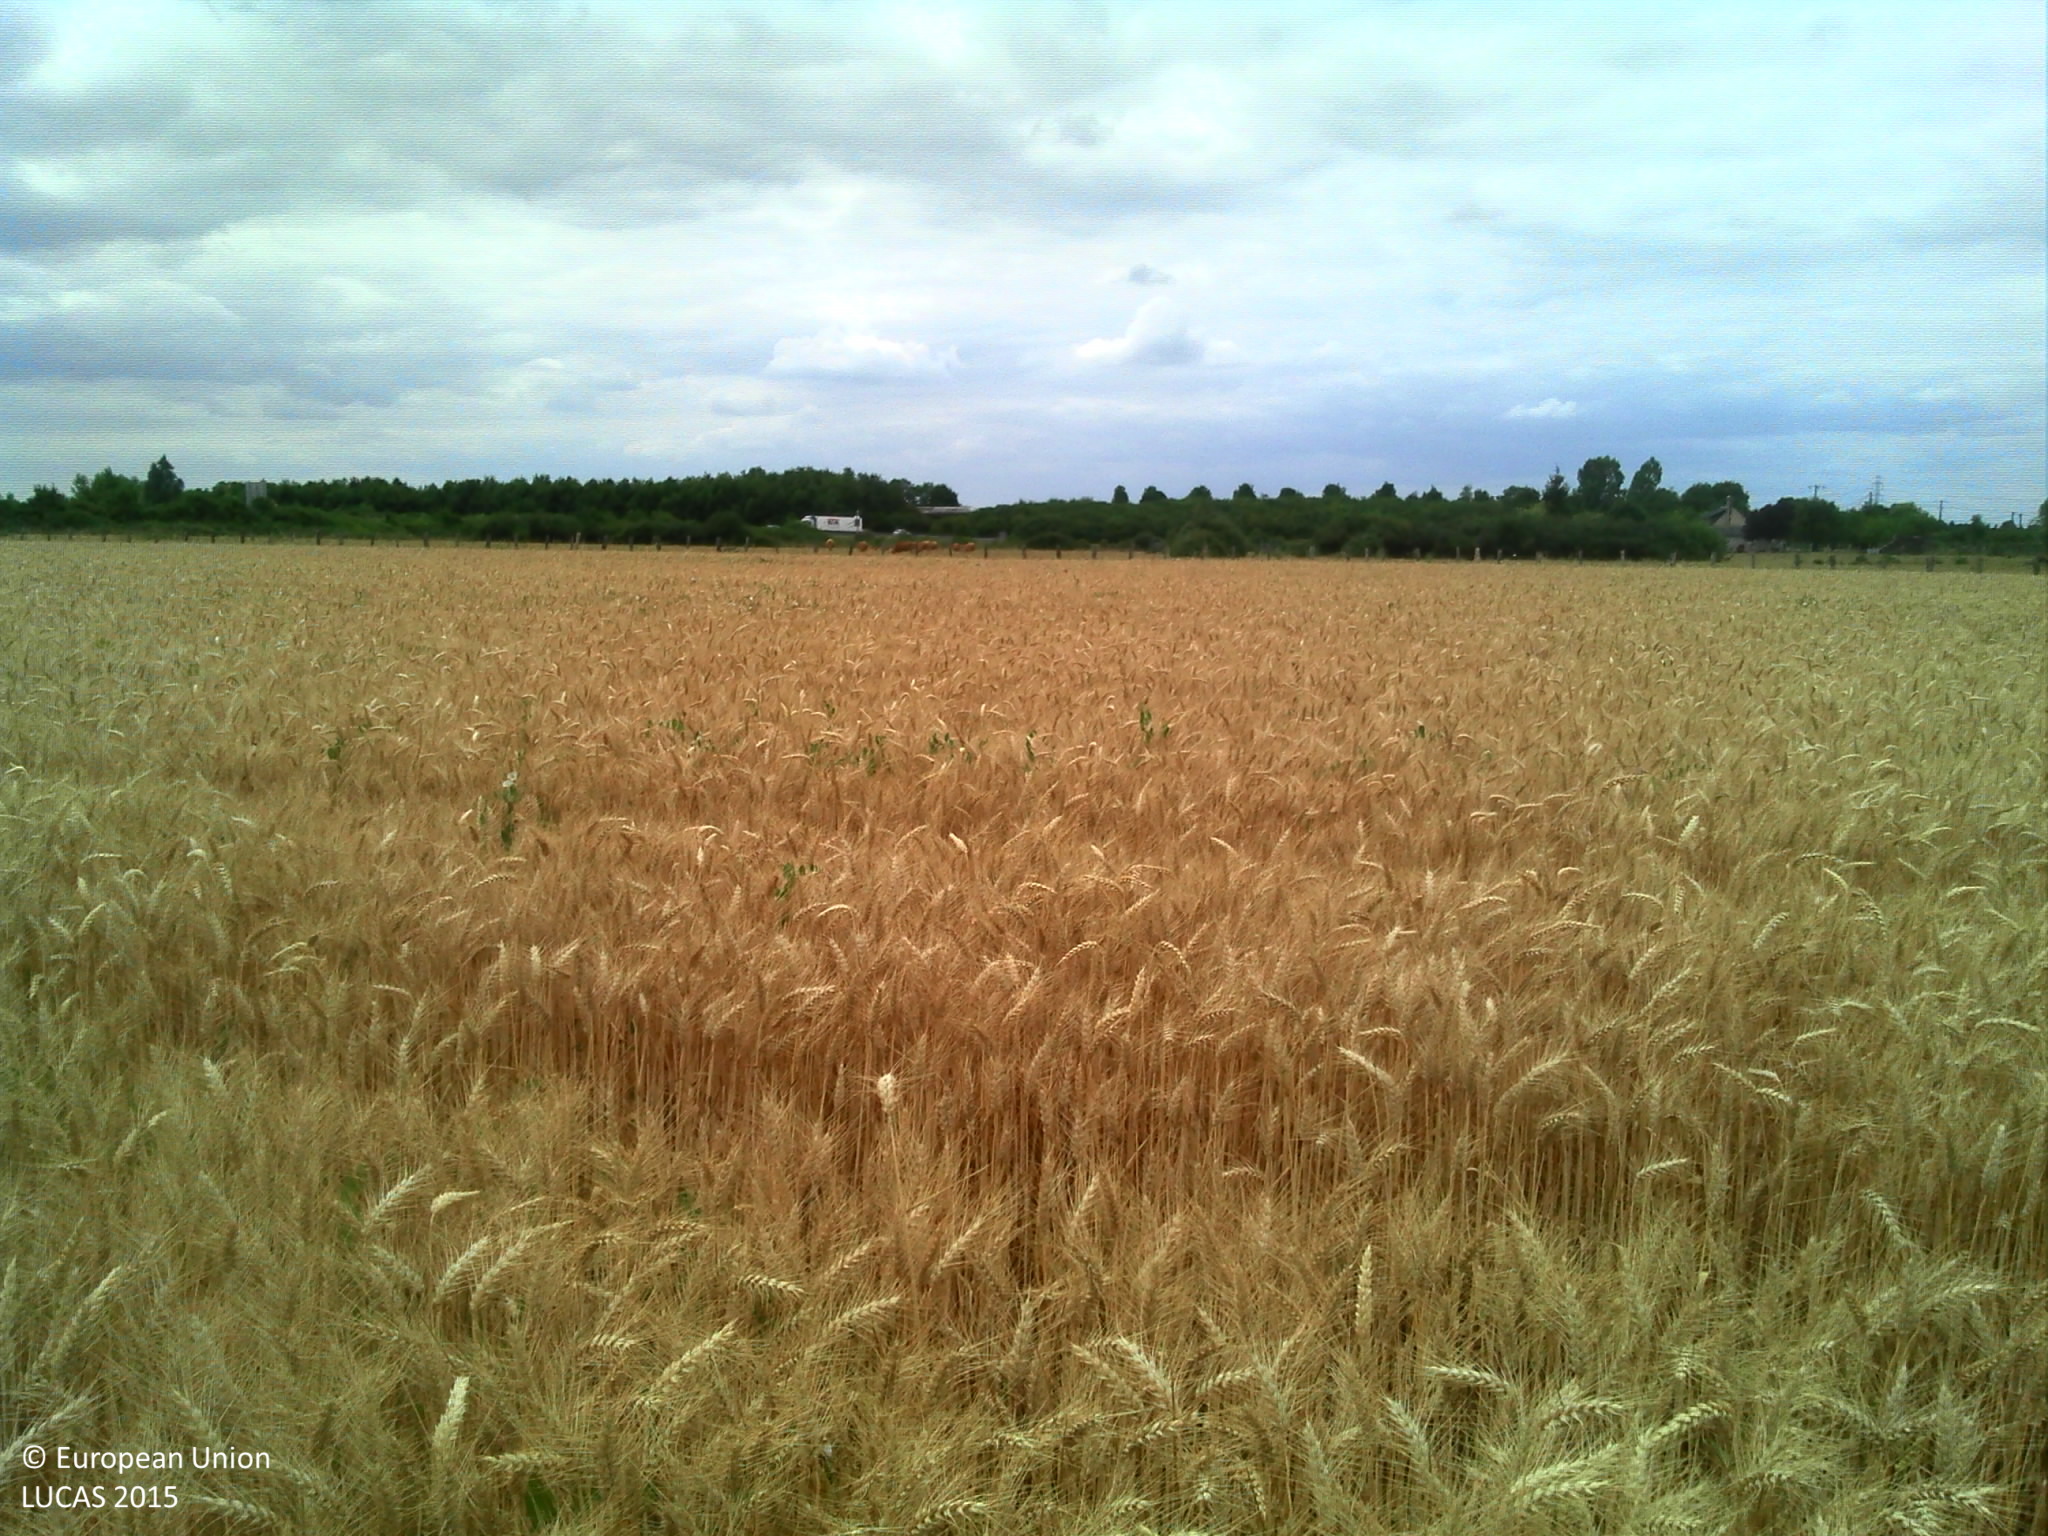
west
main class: Cropland
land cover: Common wheat
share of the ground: > 75 %
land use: Agriculture (excluding fallow land and kitchen gardens)
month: July
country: FR
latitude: 47.3070
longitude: 0.5222
